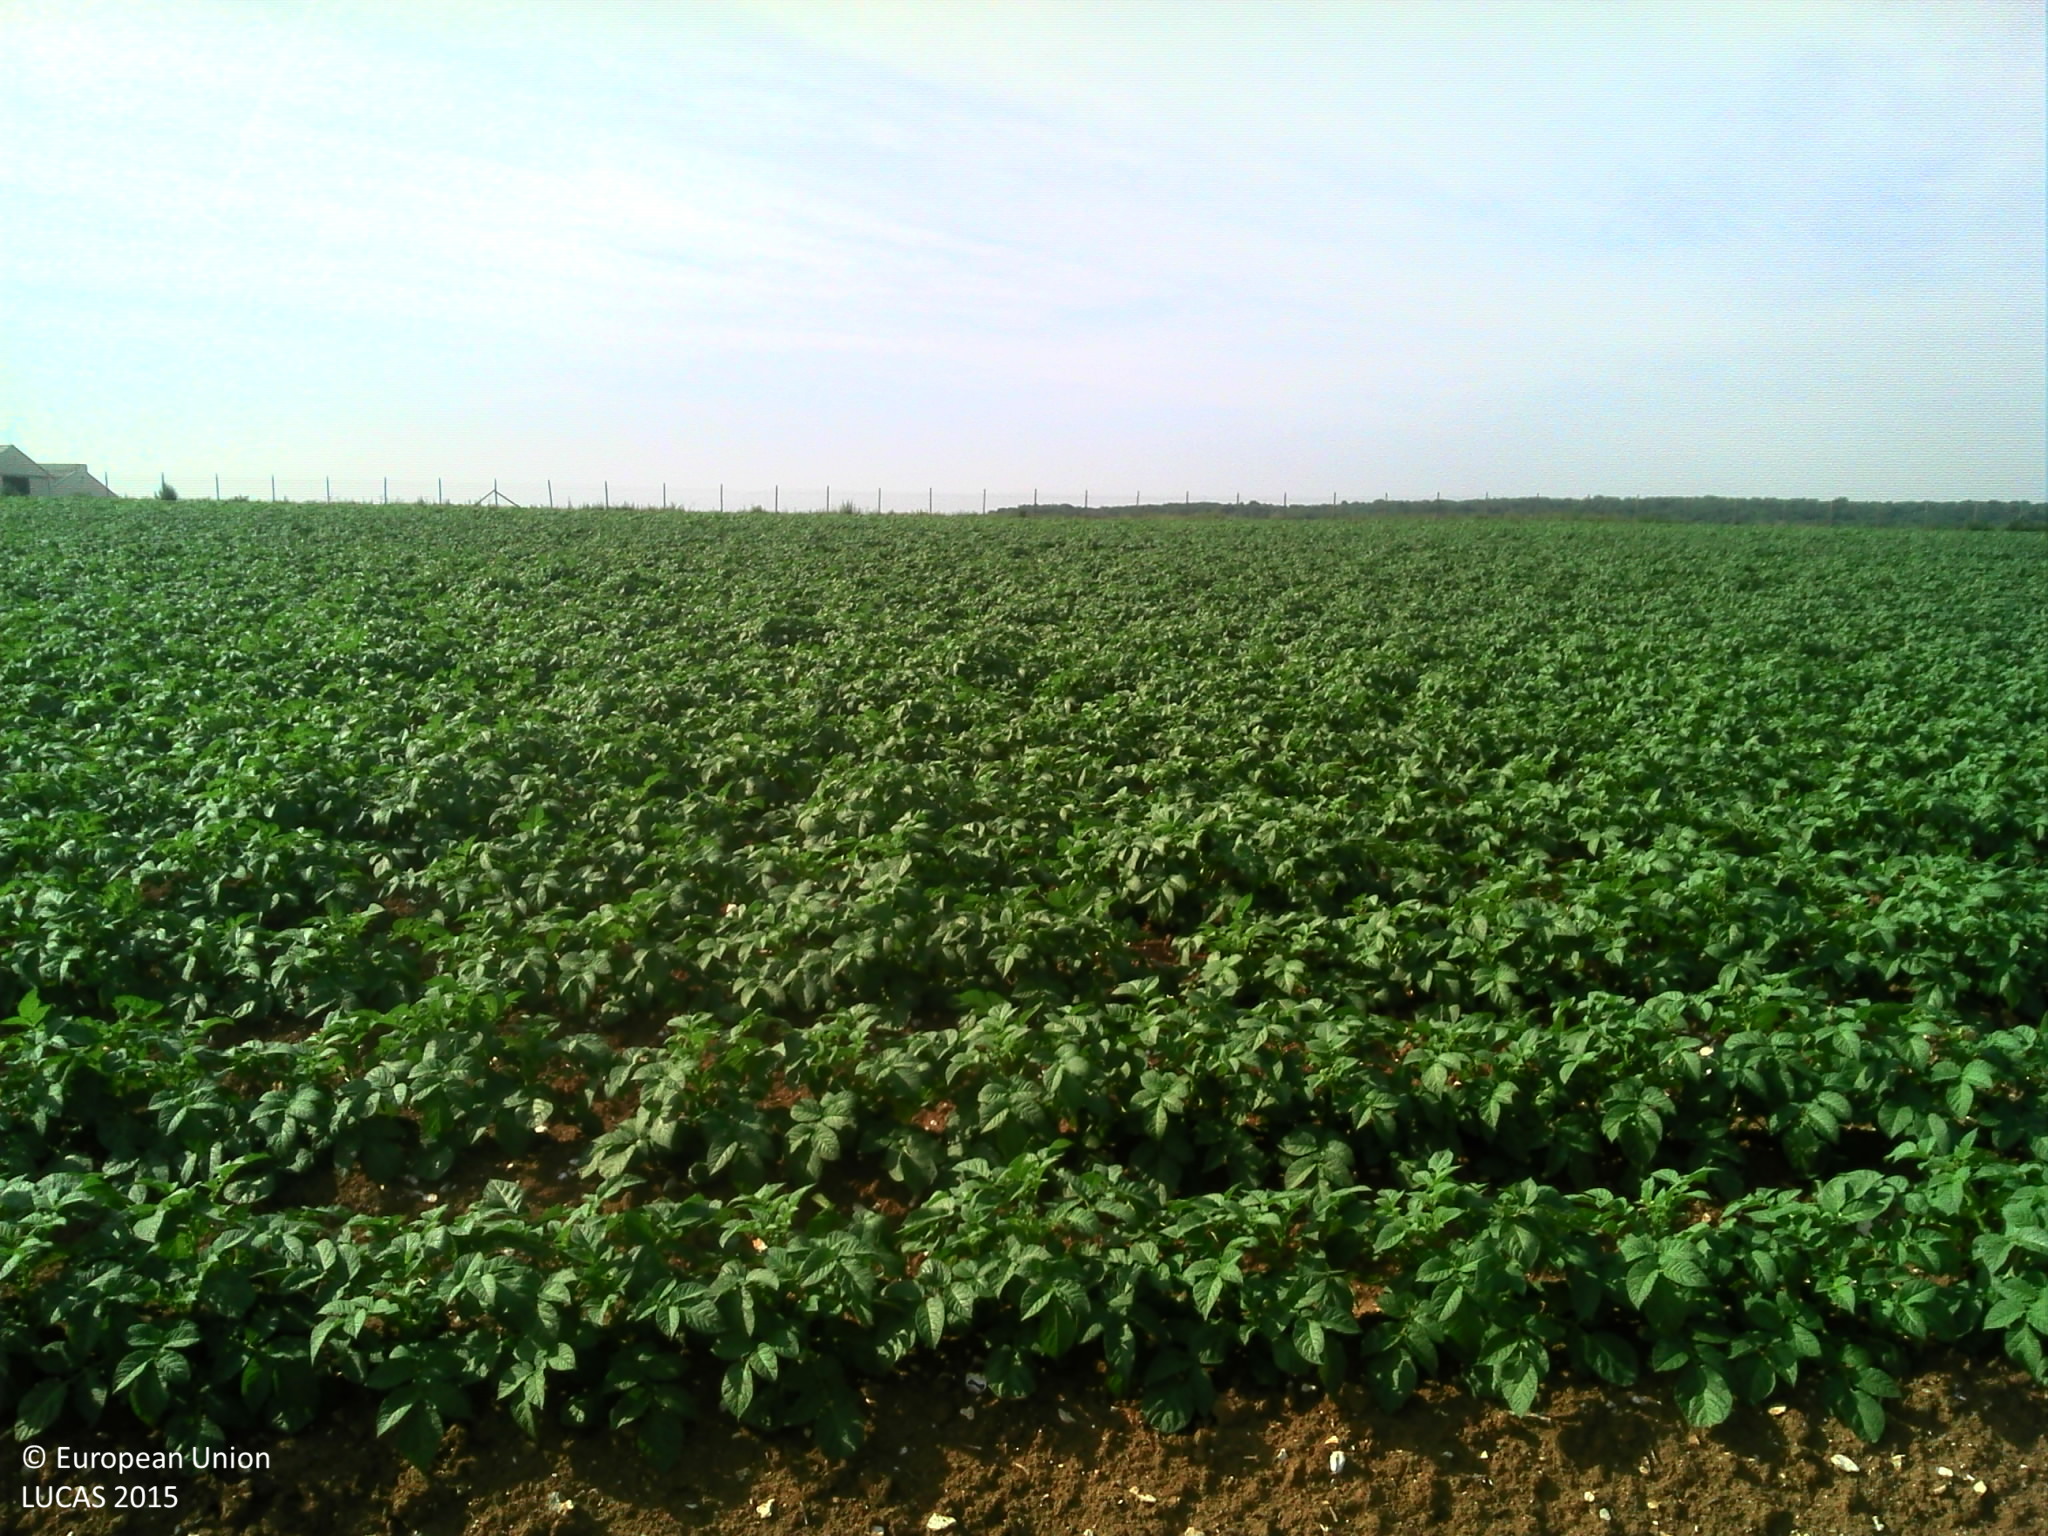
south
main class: Cropland
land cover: Potatoes
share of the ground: > 75 %
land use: Agriculture (excluding fallow land and kitchen gardens)
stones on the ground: 10 - 25 %
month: June
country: FR
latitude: 49.7260
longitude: 2.3154
